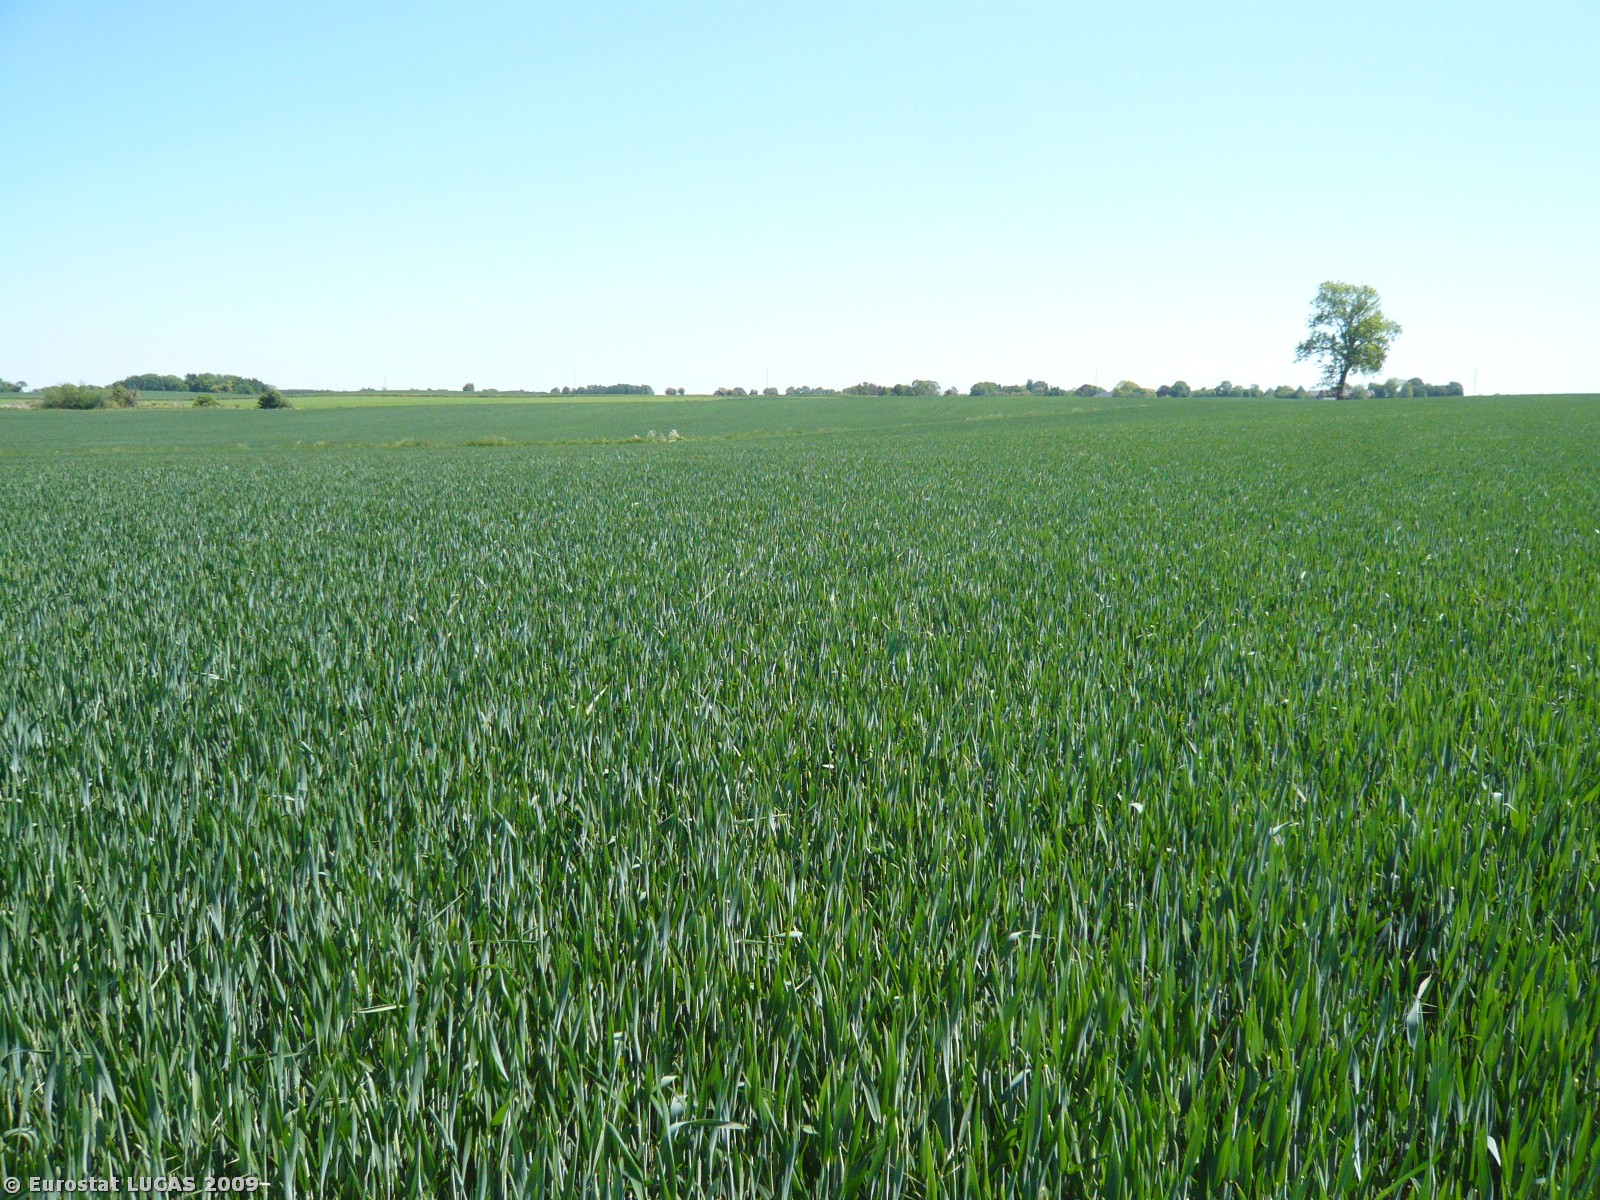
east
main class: Cropland
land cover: Common wheat
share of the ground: > 75 %
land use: Agriculture (excluding fallow land and kitchen gardens)
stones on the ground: < 10 %
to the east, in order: Common wheat; Paved roads, cycling and walking lanes; Common wheat
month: June
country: DK
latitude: 55.6664
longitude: 12.1444
